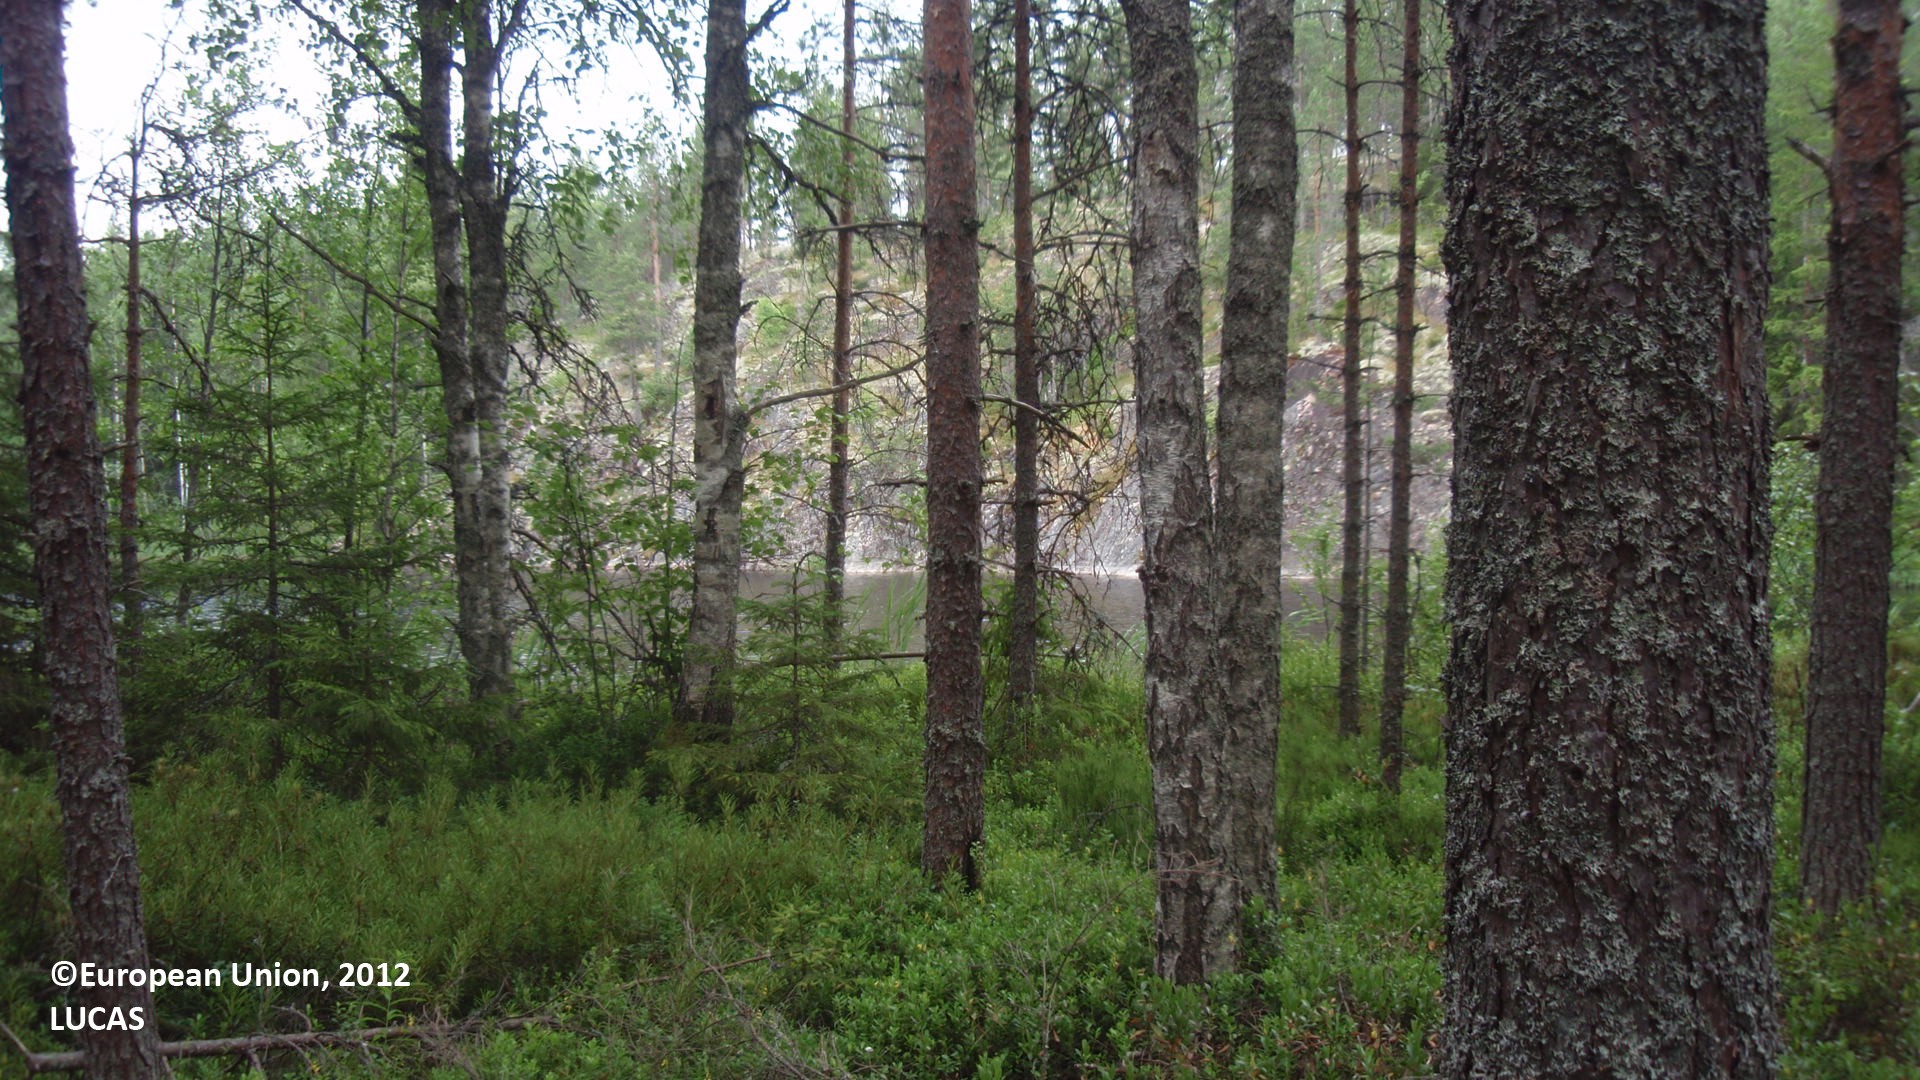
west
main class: Woodland
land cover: Pine dominated coniferous woodland
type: boreal forest
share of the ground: 25 - 50 %
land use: Forestry
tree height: > 5 m
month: July
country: FI
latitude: 61.5366
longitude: 28.8256
